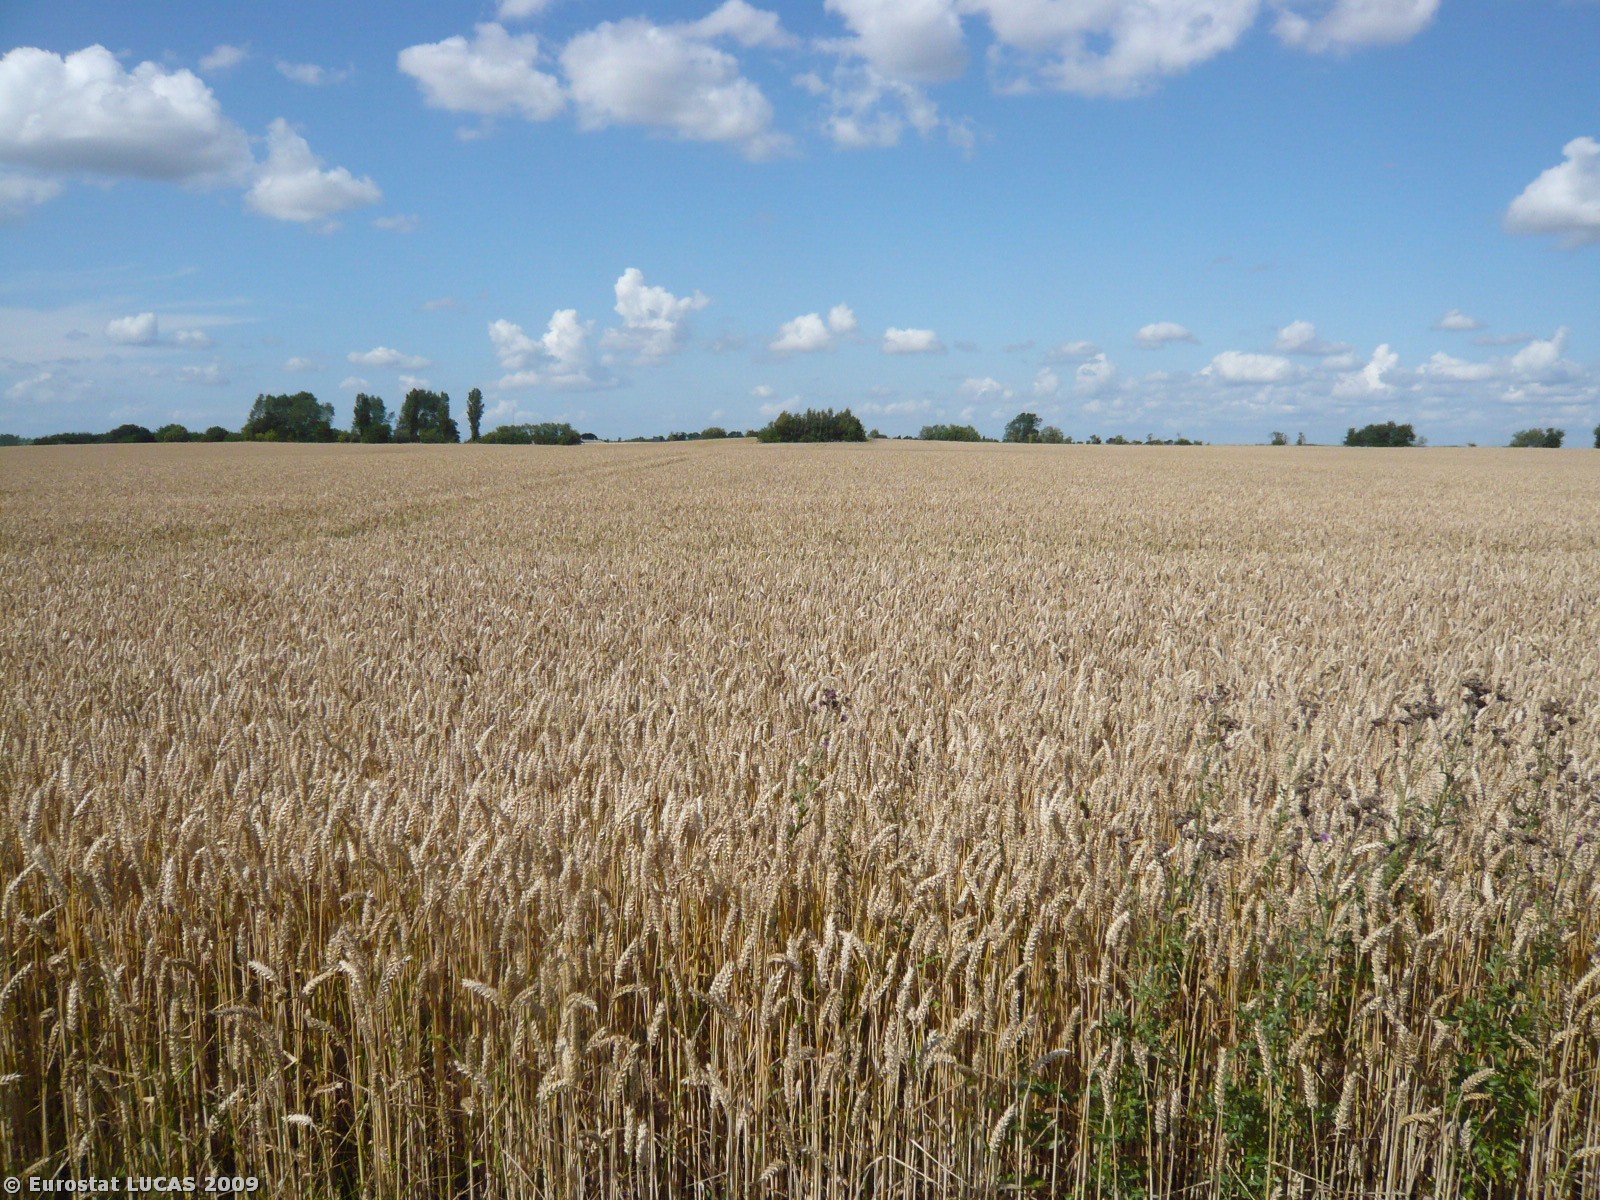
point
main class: Cropland
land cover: Common wheat
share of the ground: > 75 %
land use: Agriculture (excluding fallow land and kitchen gardens)
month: July
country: DK
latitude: 55.5760
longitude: 12.1712
